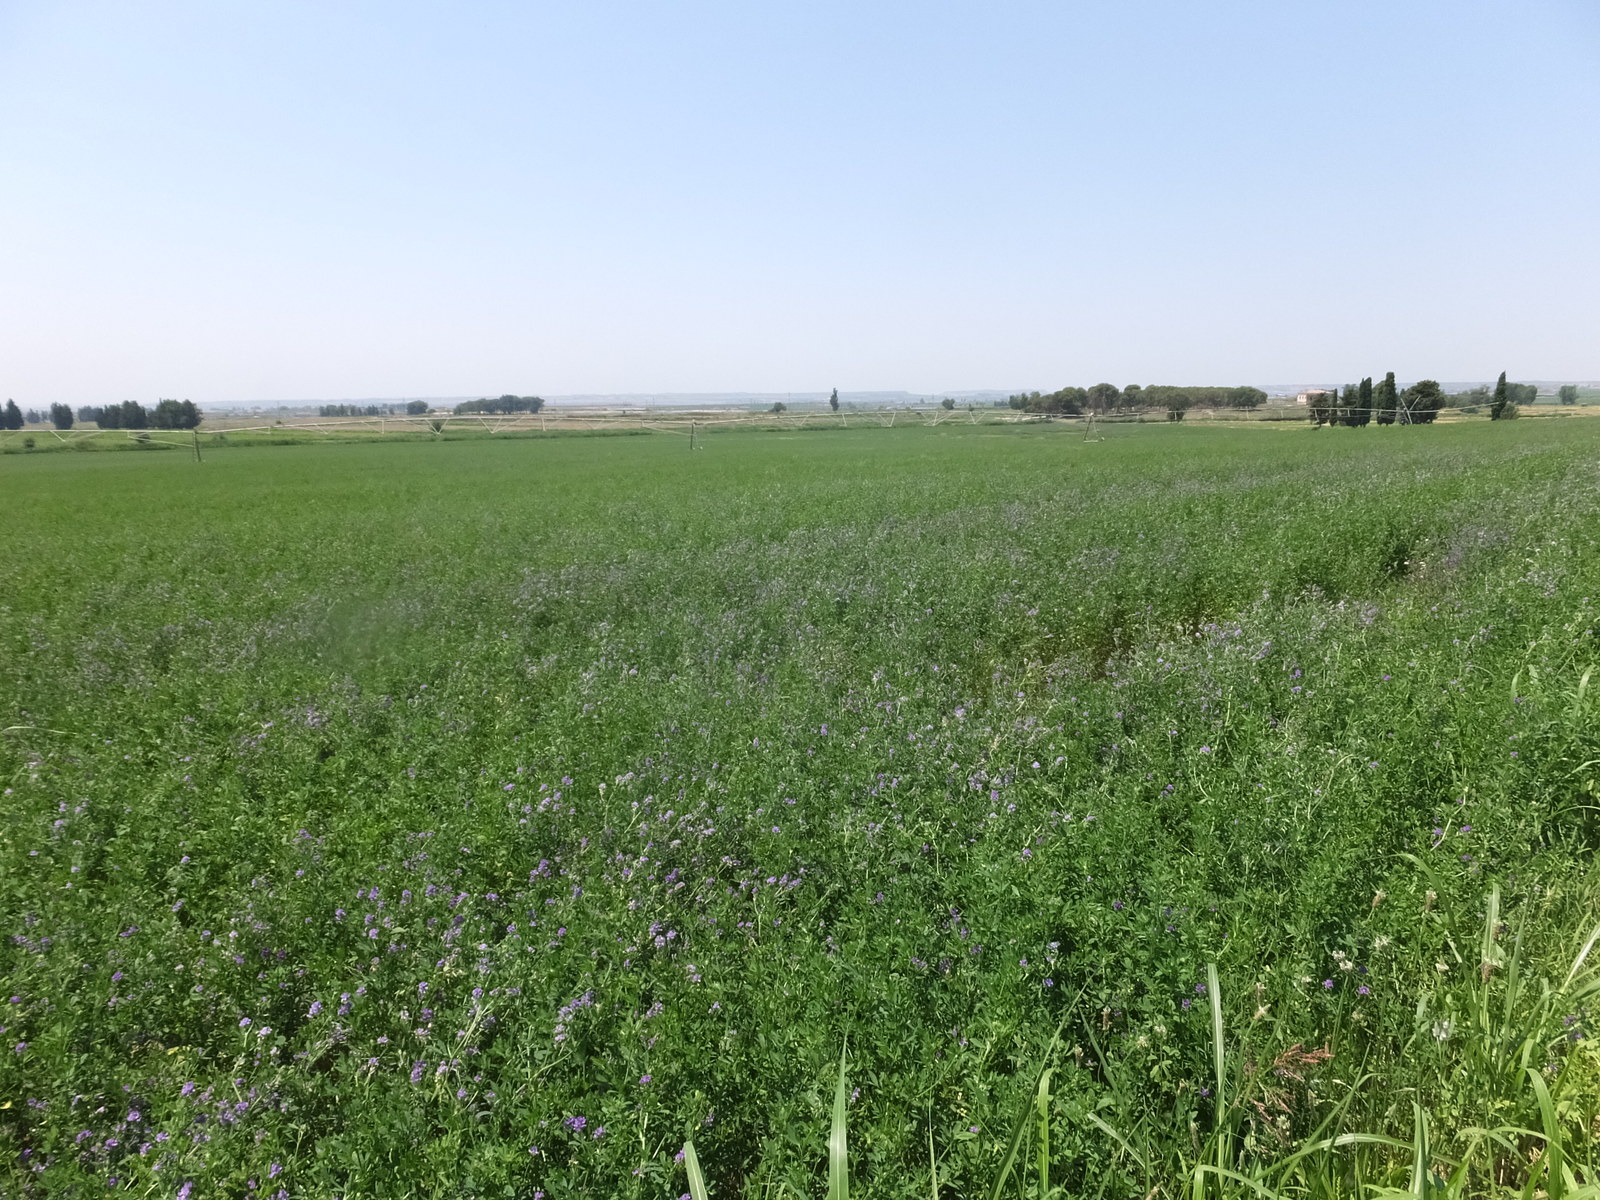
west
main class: Cropland
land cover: Lucerne
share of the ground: > 75 %
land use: Agriculture (excluding fallow land and kitchen gardens)
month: June
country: ES
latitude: 41.7965
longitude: 0.3936
